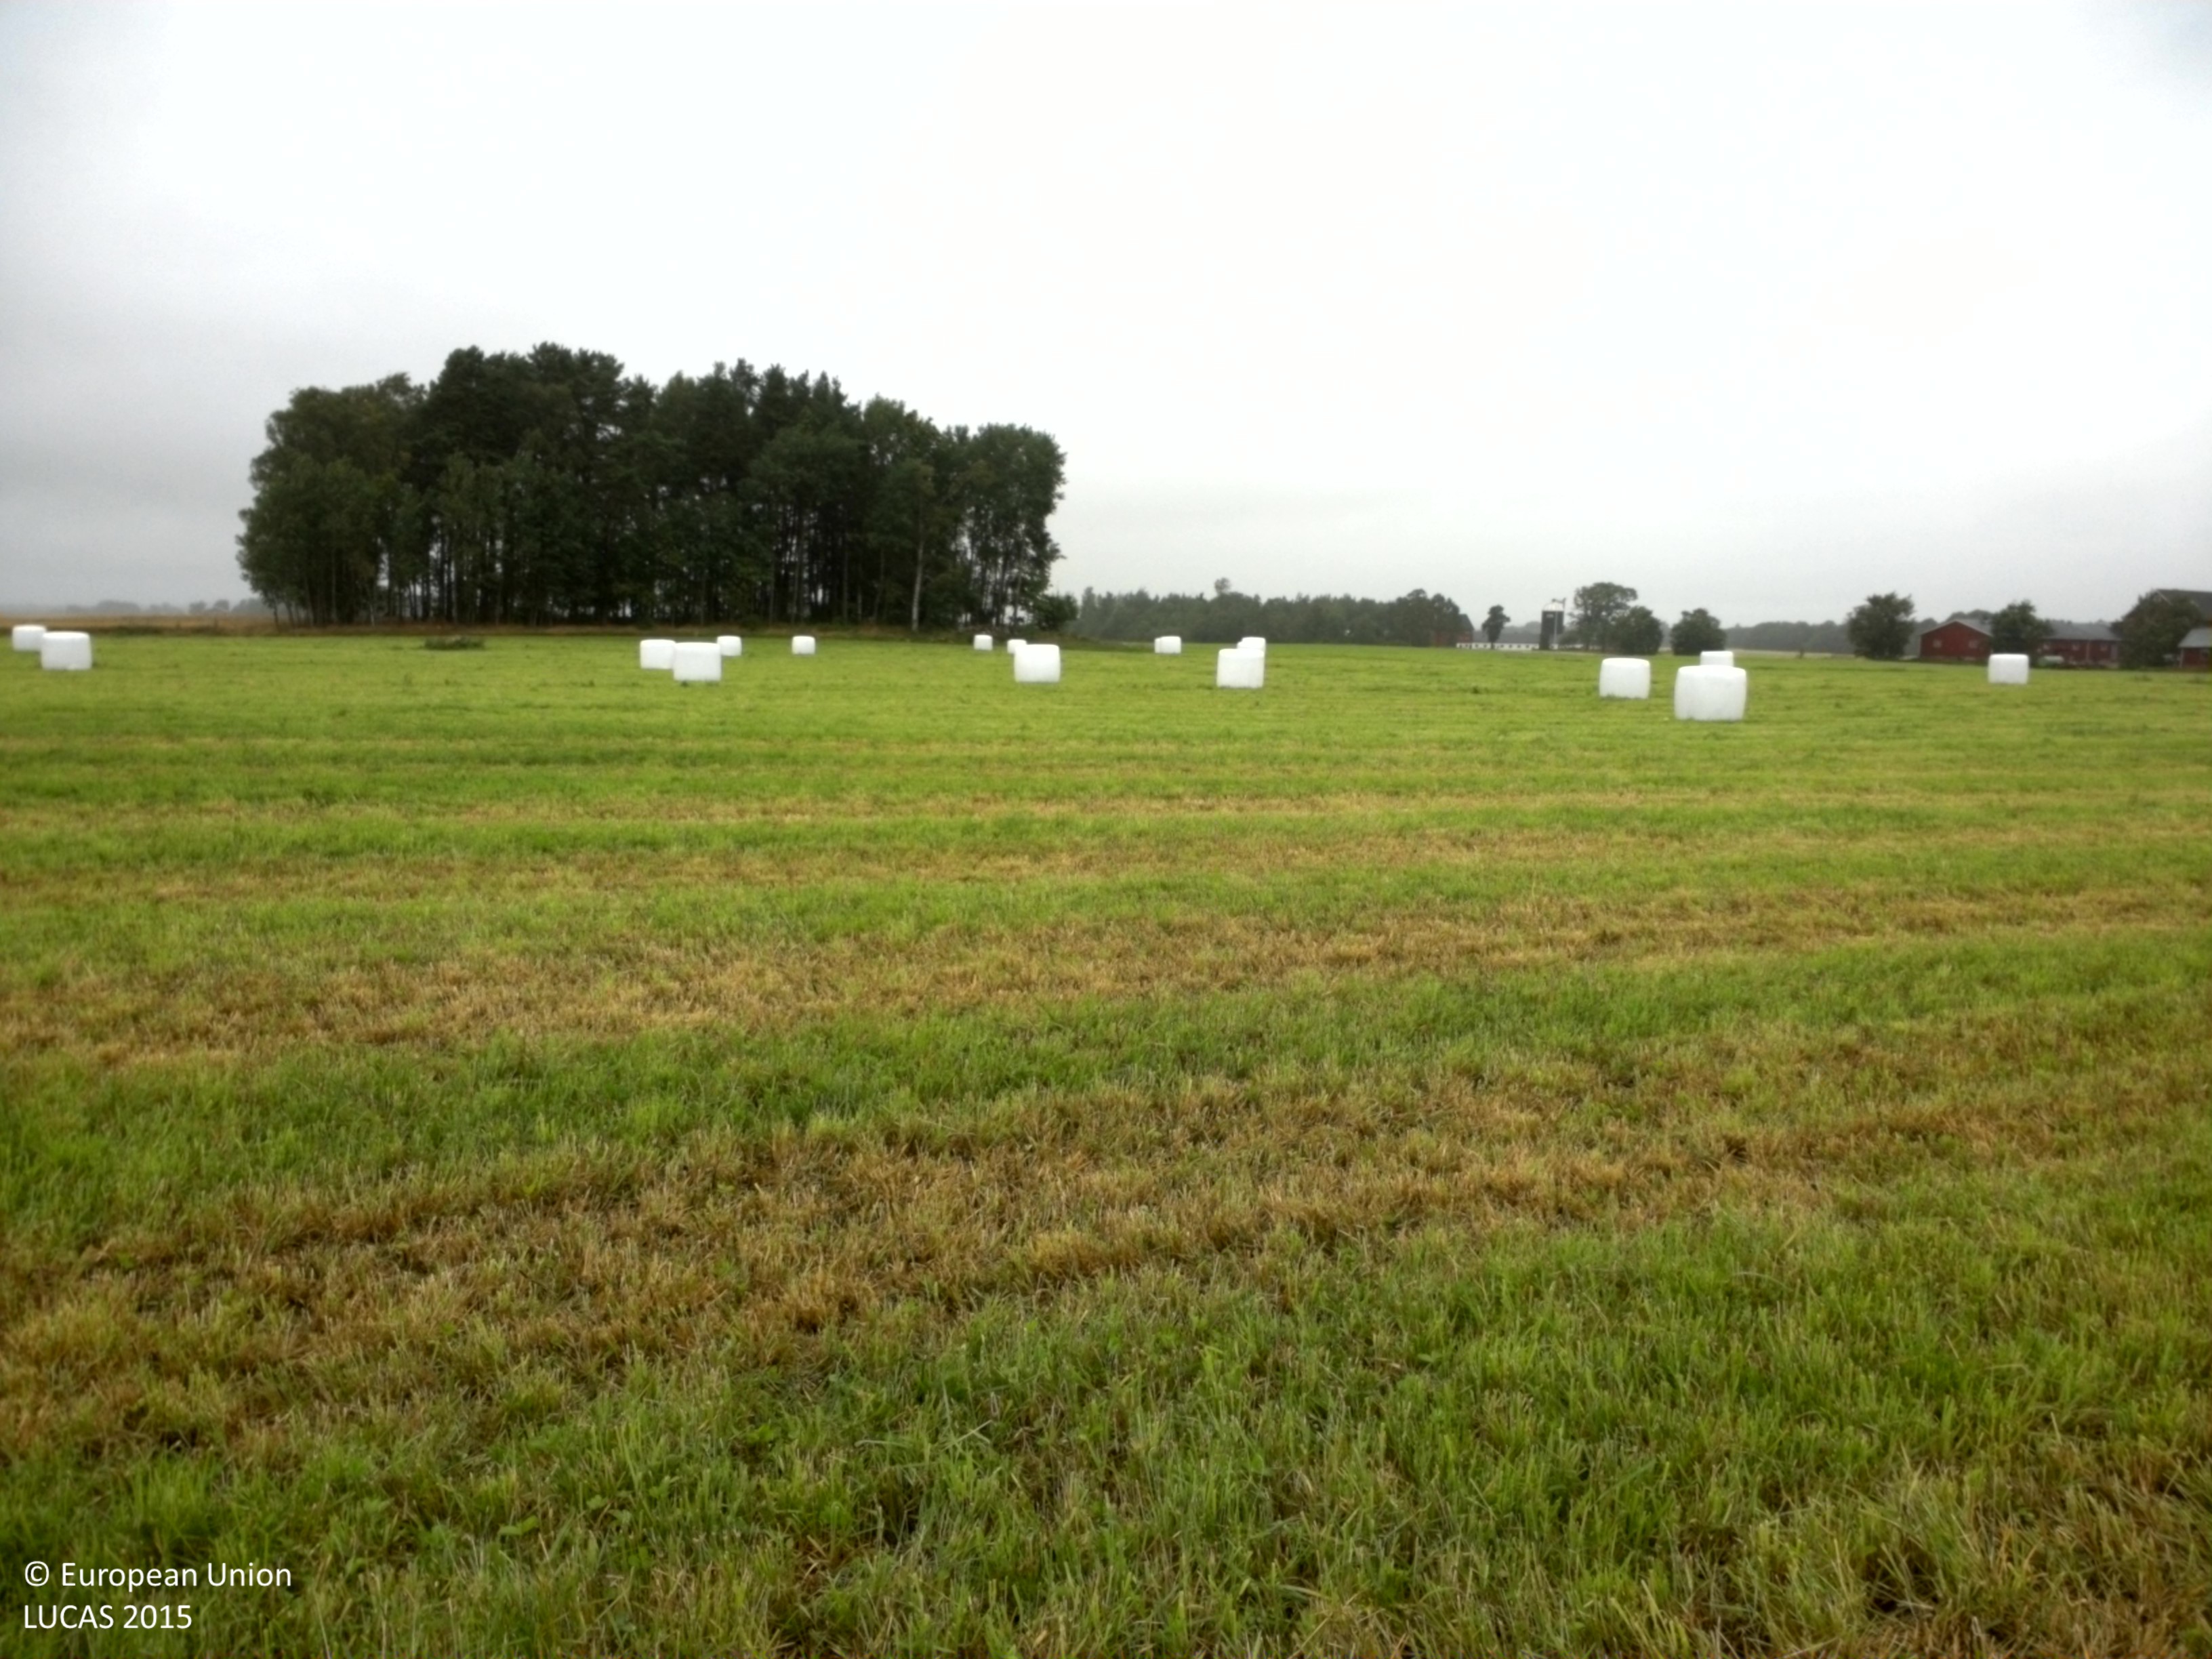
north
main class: Cropland
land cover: Other leguminous and mixtures for fodder
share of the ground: > 75 %
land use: Agriculture (excluding fallow land and kitchen gardens)
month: July
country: SE
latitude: 58.4653
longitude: 13.3711
